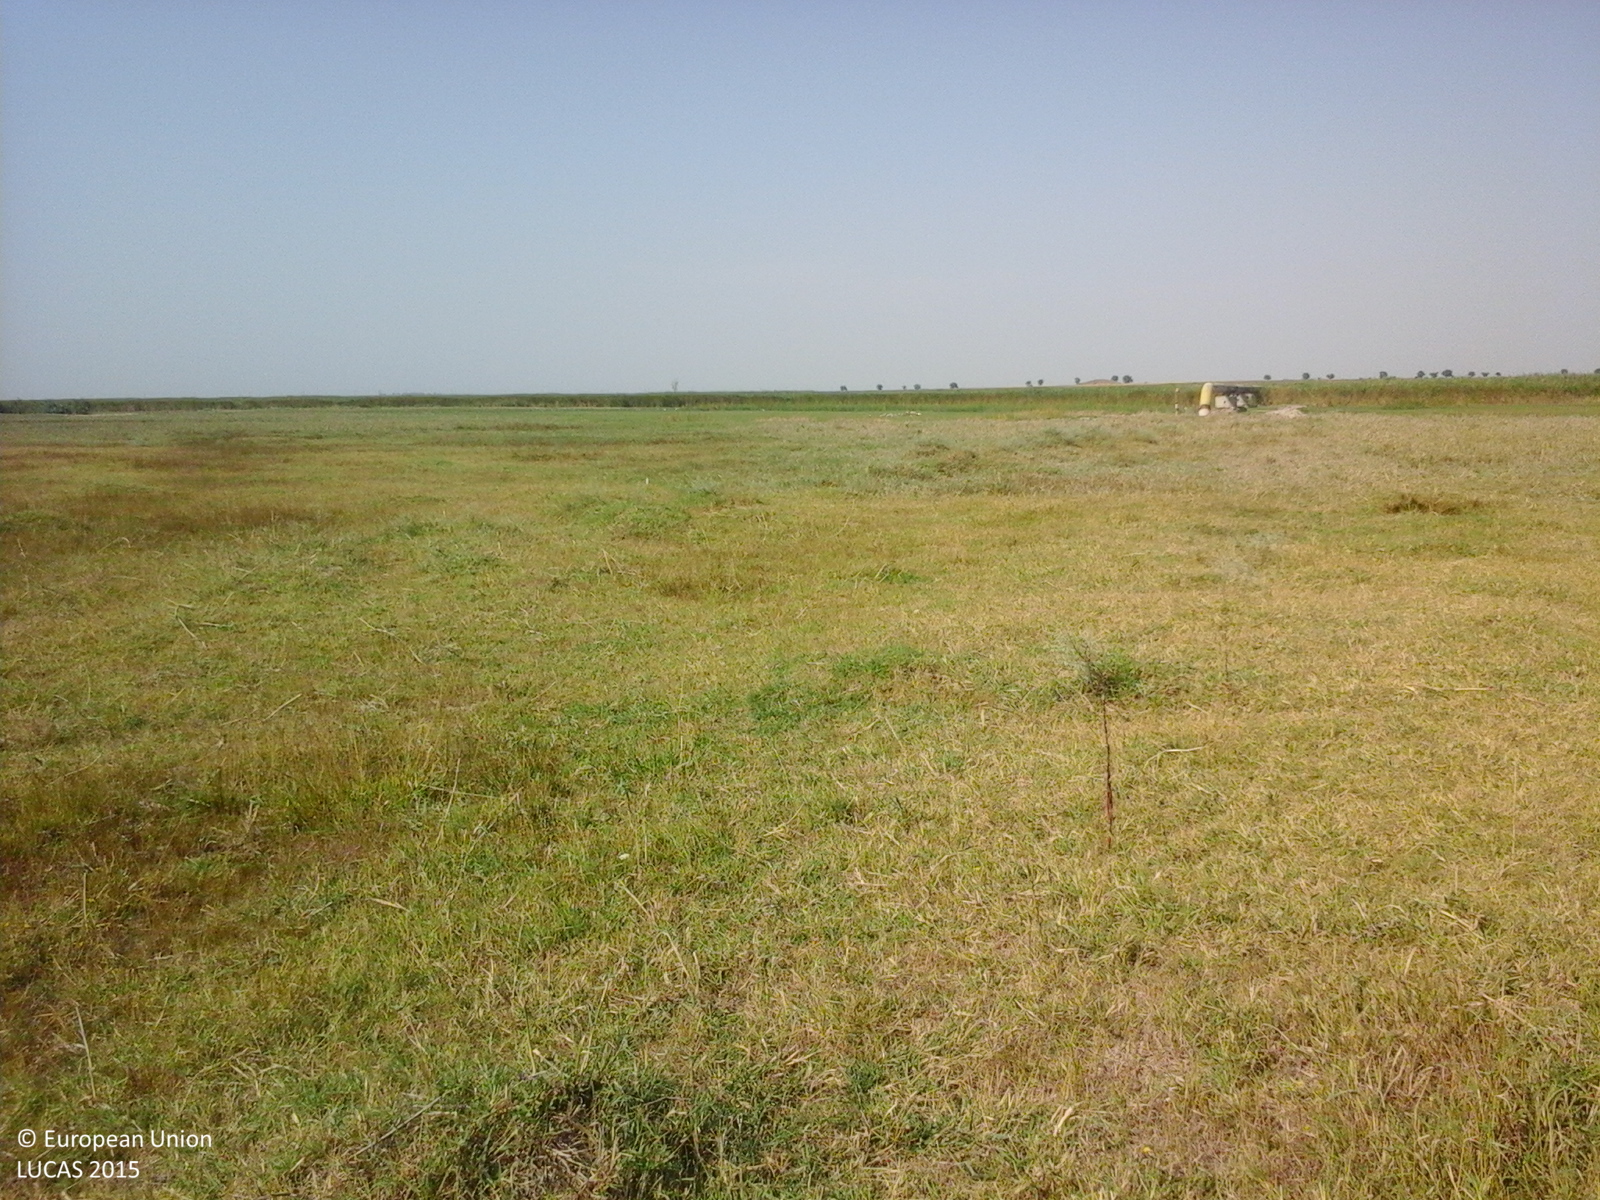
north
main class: Grassland
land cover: Grassland without tree/shrub cover
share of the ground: > 75 %
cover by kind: herbaceous plants 100 %
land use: Agriculture (excluding fallow land and kitchen gardens)
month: August
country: RO
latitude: 45.2074
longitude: 27.7142
